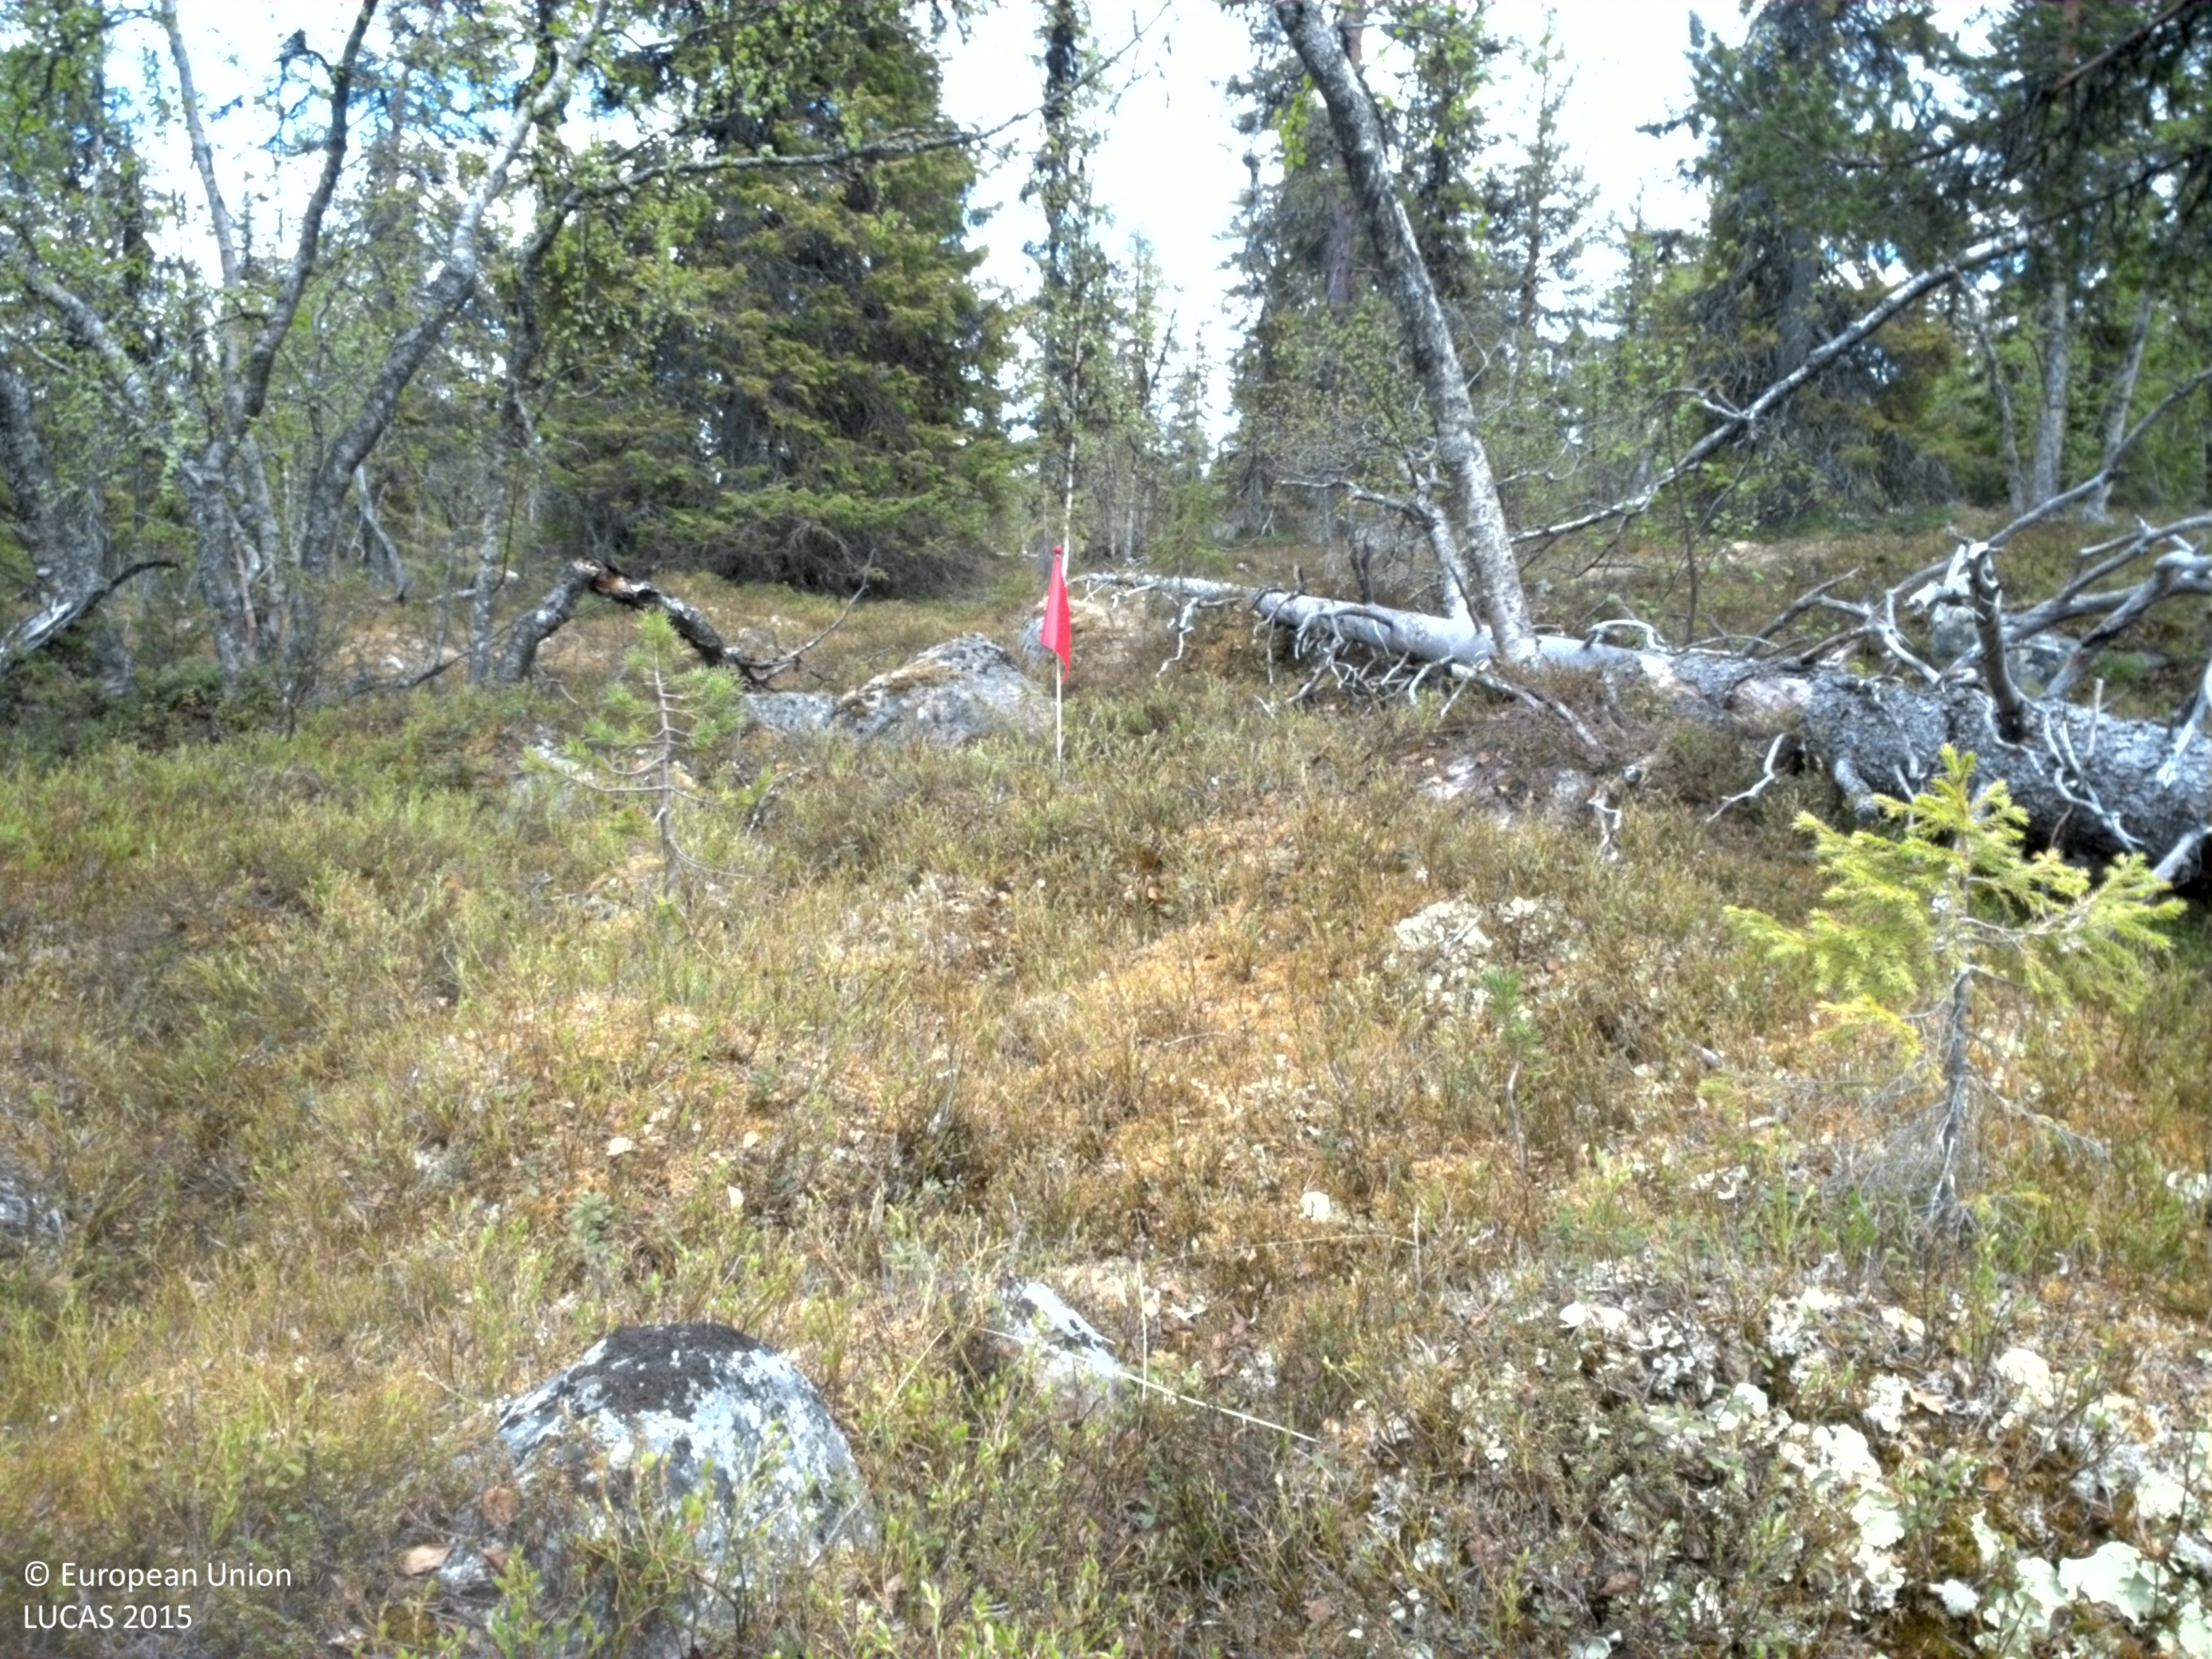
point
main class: Woodland
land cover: Other mixed woodland
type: boreal forest
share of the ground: 25 - 50 %
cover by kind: shrubs 50 %, coniferous forest trees 25 %, broadleaved forest trees 10 %, consolidated bare surface 10 %, lichens and mosses 5 %
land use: Forestry
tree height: > 5 m
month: June
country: SE
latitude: 66.1435
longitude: 19.3728
